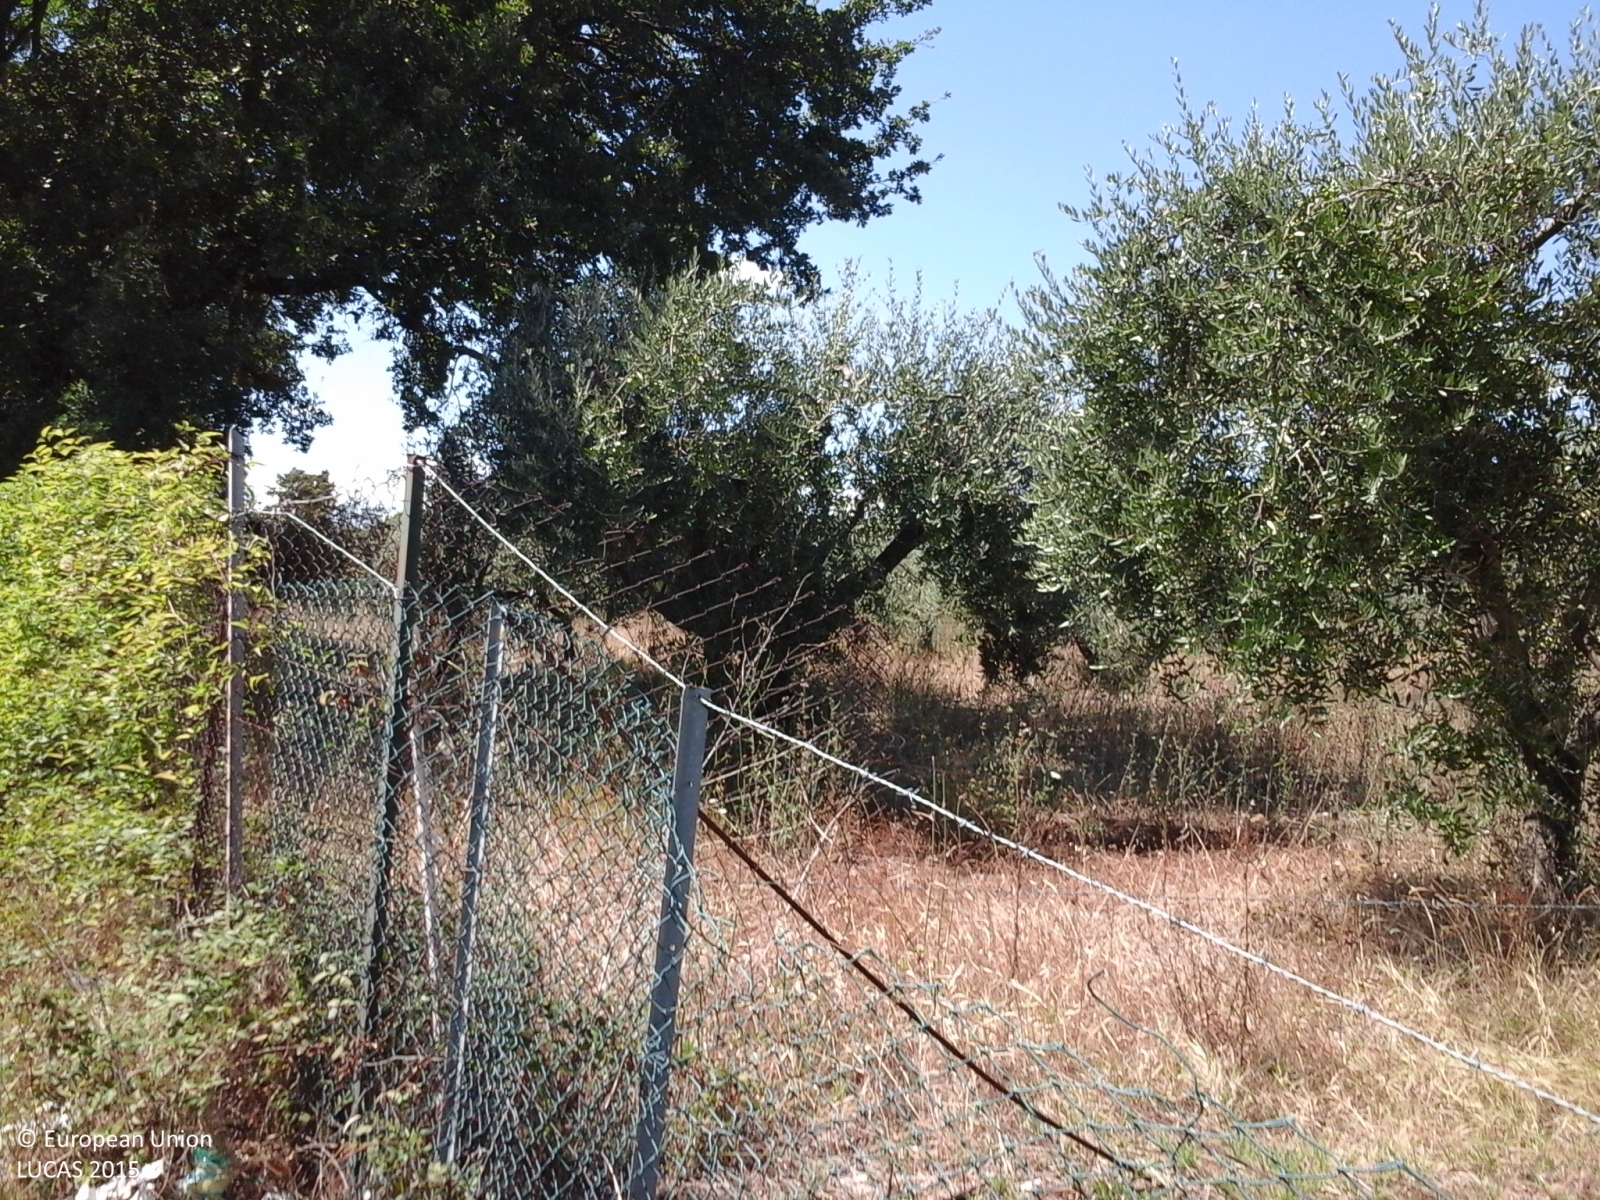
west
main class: Cropland
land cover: Olive groves
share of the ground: 25 - 50 %
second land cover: Grassland without tree/shrub cover
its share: > 75 %
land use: Agriculture (excluding fallow land and kitchen gardens)
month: August
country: IT
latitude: 41.9652
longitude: 12.7772
